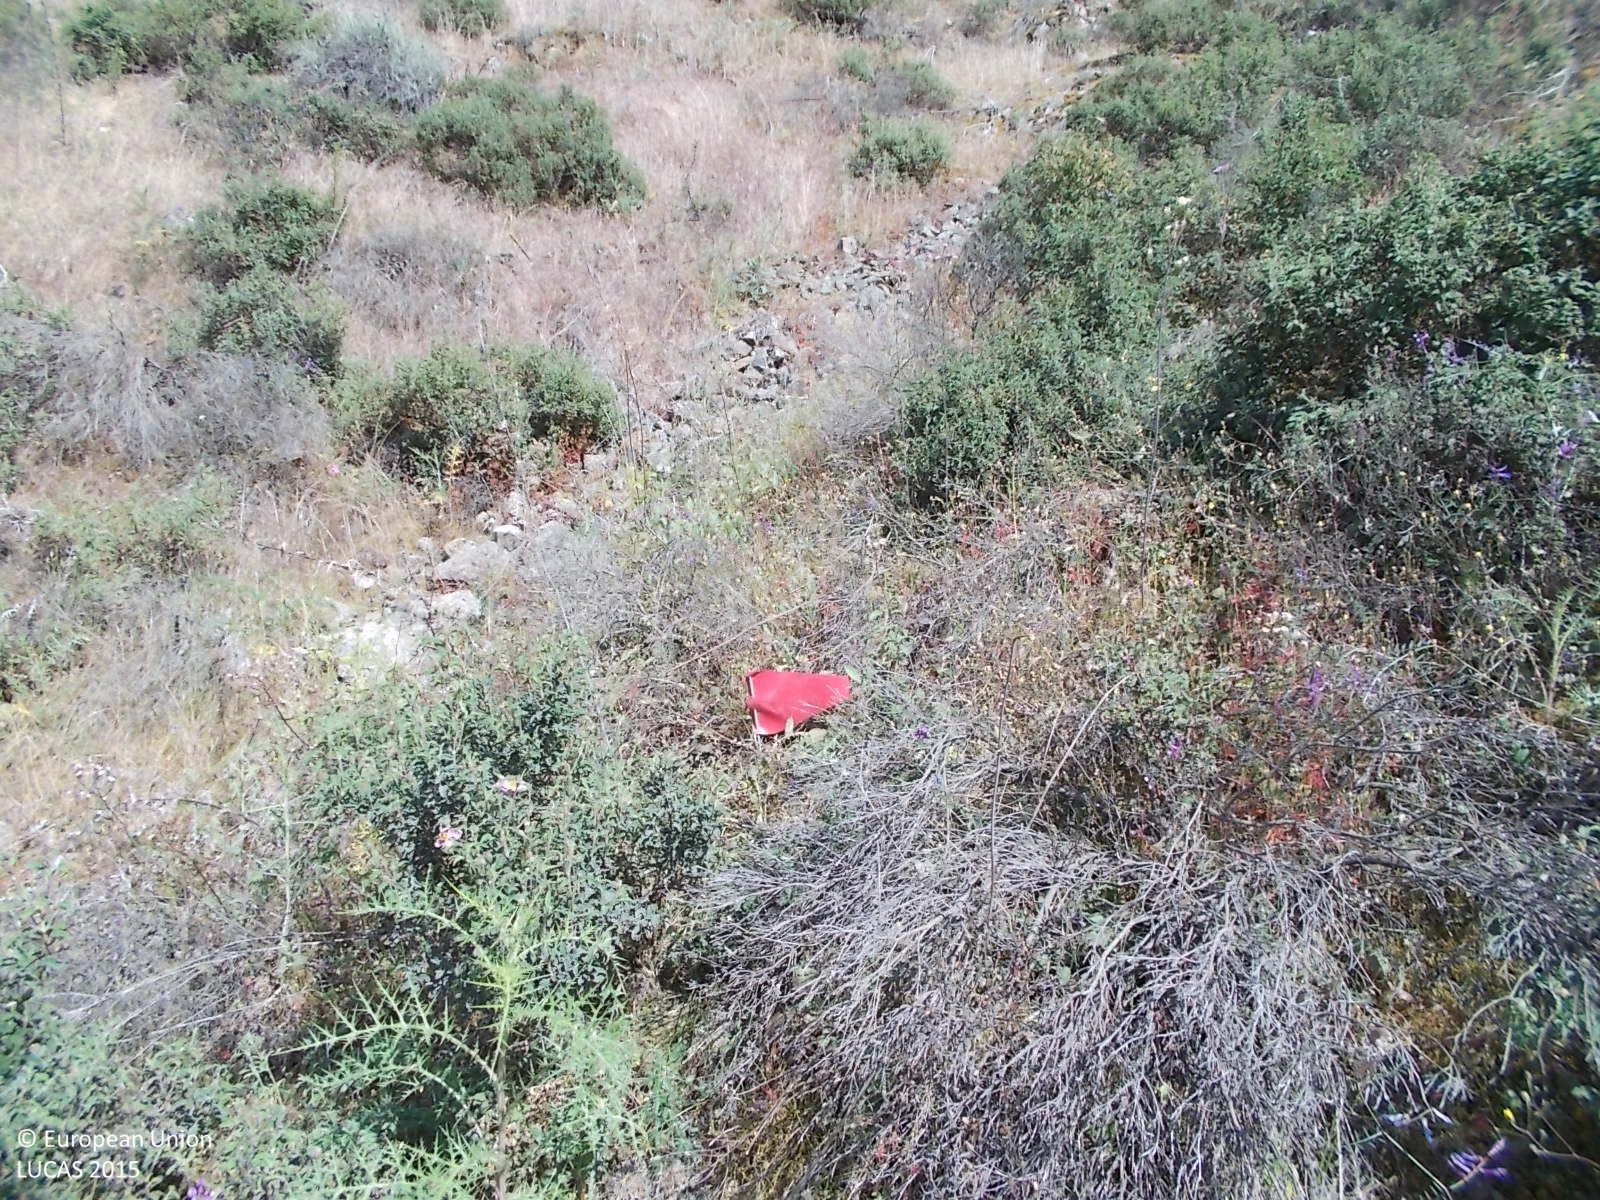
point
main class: Woodland
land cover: Pine dominated coniferous woodland
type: coniferous forest of the mediterranean region
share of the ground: 10 - 25 %
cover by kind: shrubs 40 %, herbaceous plants 35 %, coniferous forest trees 15 %, unconsolidated bare surface 10 %
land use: Forestry
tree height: > 5 m
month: May
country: CY
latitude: 34.9795
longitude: 33.0812
